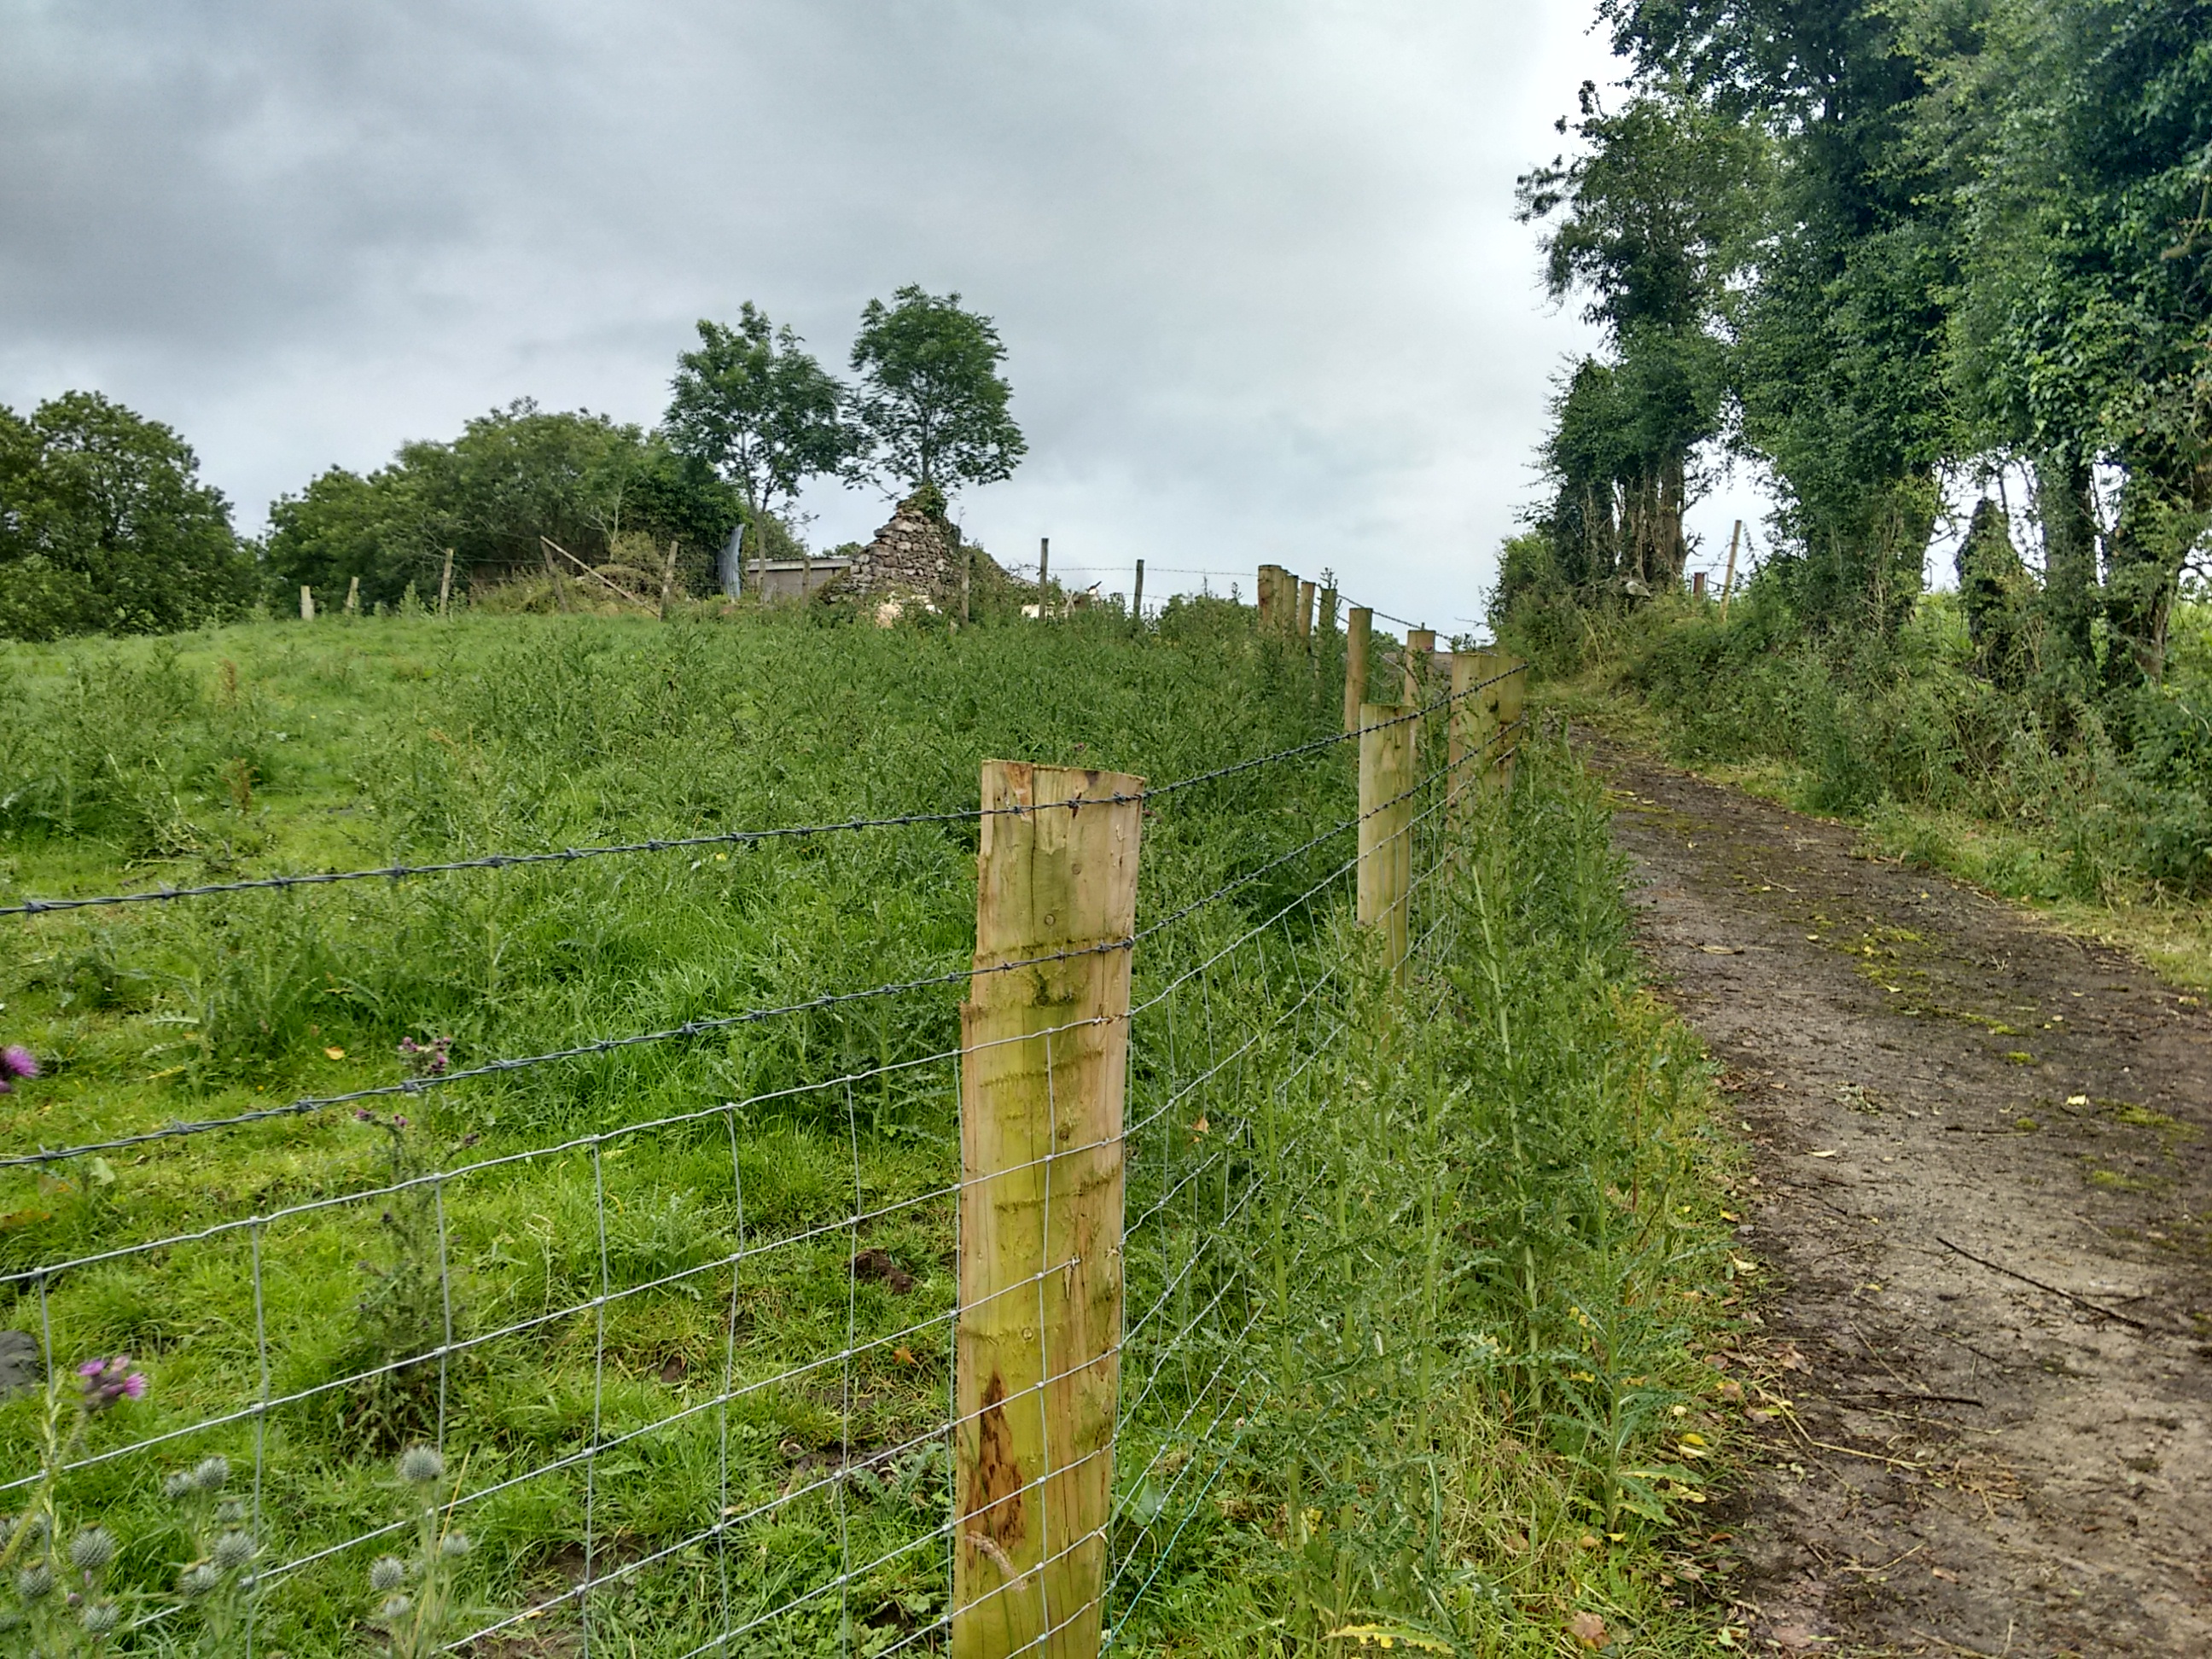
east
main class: Grassland
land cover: Grassland without tree/shrub cover
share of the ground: > 75 %
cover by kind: herbaceous plants 100 %
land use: Agriculture (excluding fallow land and kitchen gardens)
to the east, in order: Grassland without tree/shrub cover; Abandoned hedges; Grassland without tree/shrub cover; Electric lines; Grassland without tree/shrub cover; Fences; Grassland without tree/shrub cover
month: July
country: GB
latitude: 54.4005
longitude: -7.3576
